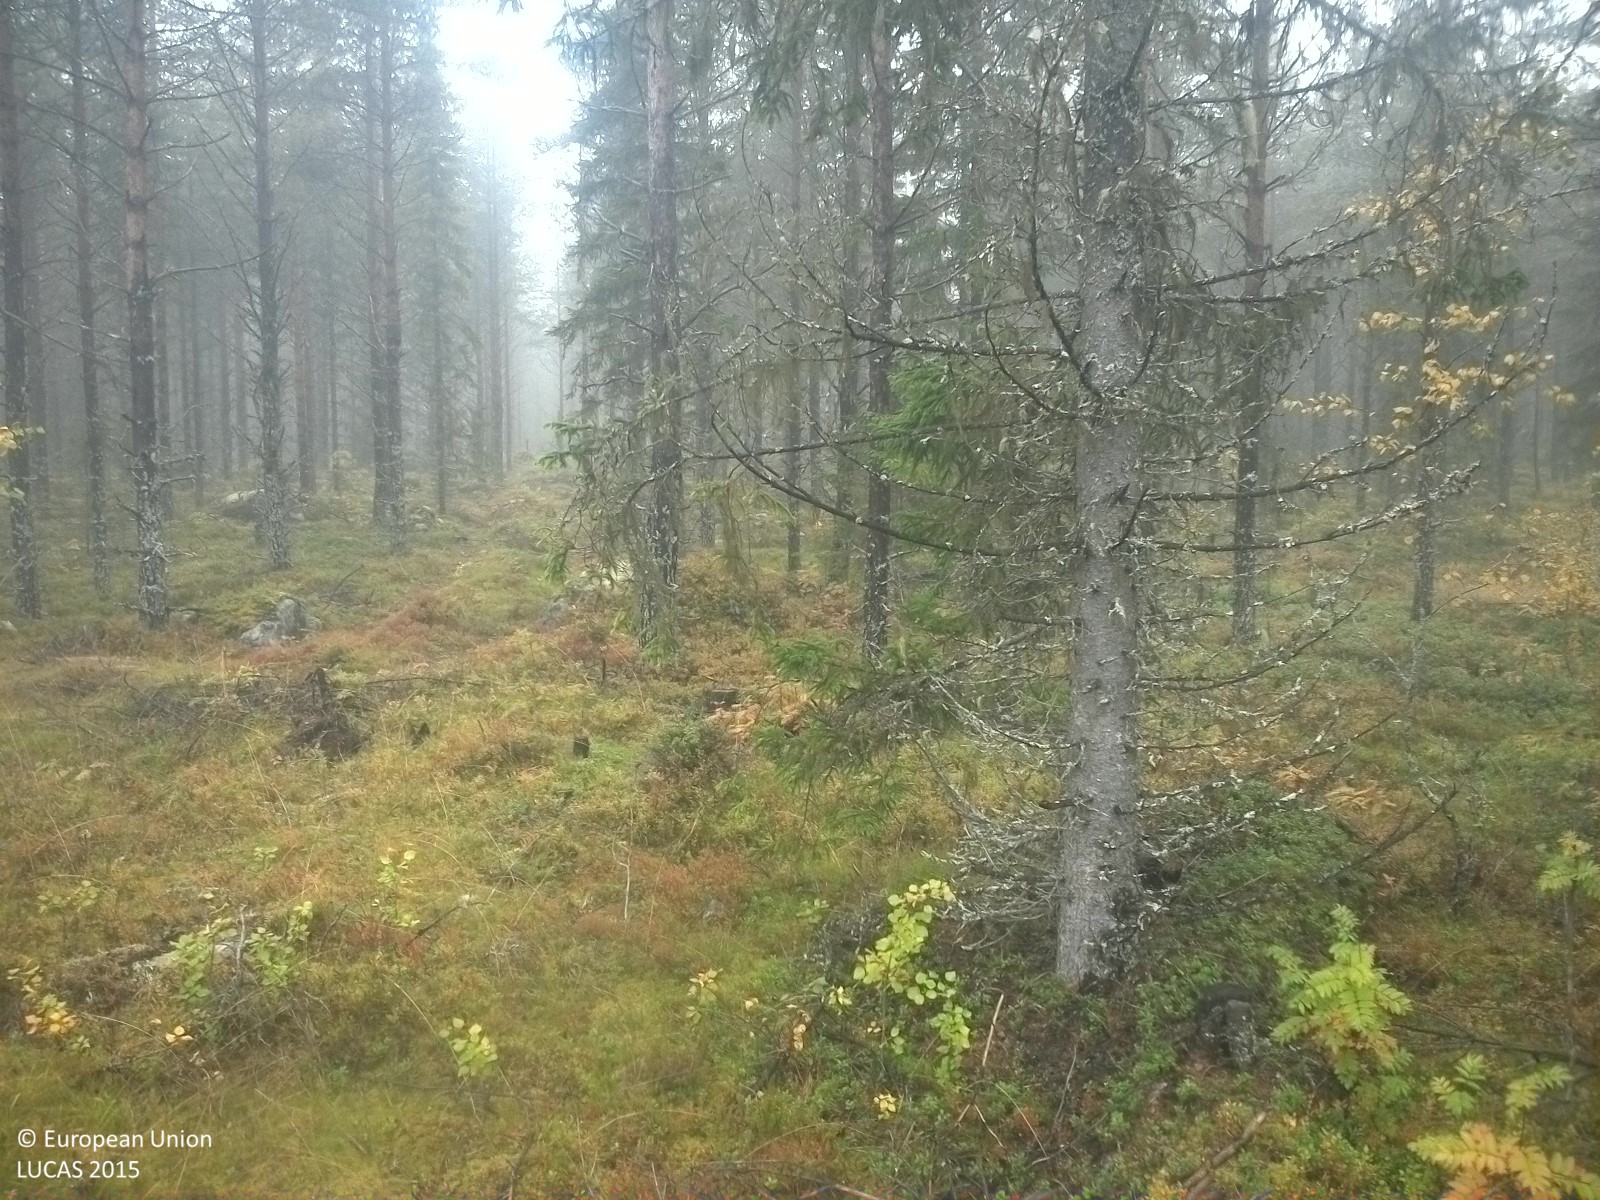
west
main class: Woodland
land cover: Other coniferous woodland
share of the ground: 50 - 75 %
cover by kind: coniferous forest trees 45 %, shrubs 30 %, herbaceous plants 10 %, lichens and mosses 10 %, broadleaved forest trees 5 %
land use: Forestry
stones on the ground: < 10 %
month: September
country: SE
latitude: 62.0001
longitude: 15.6526
